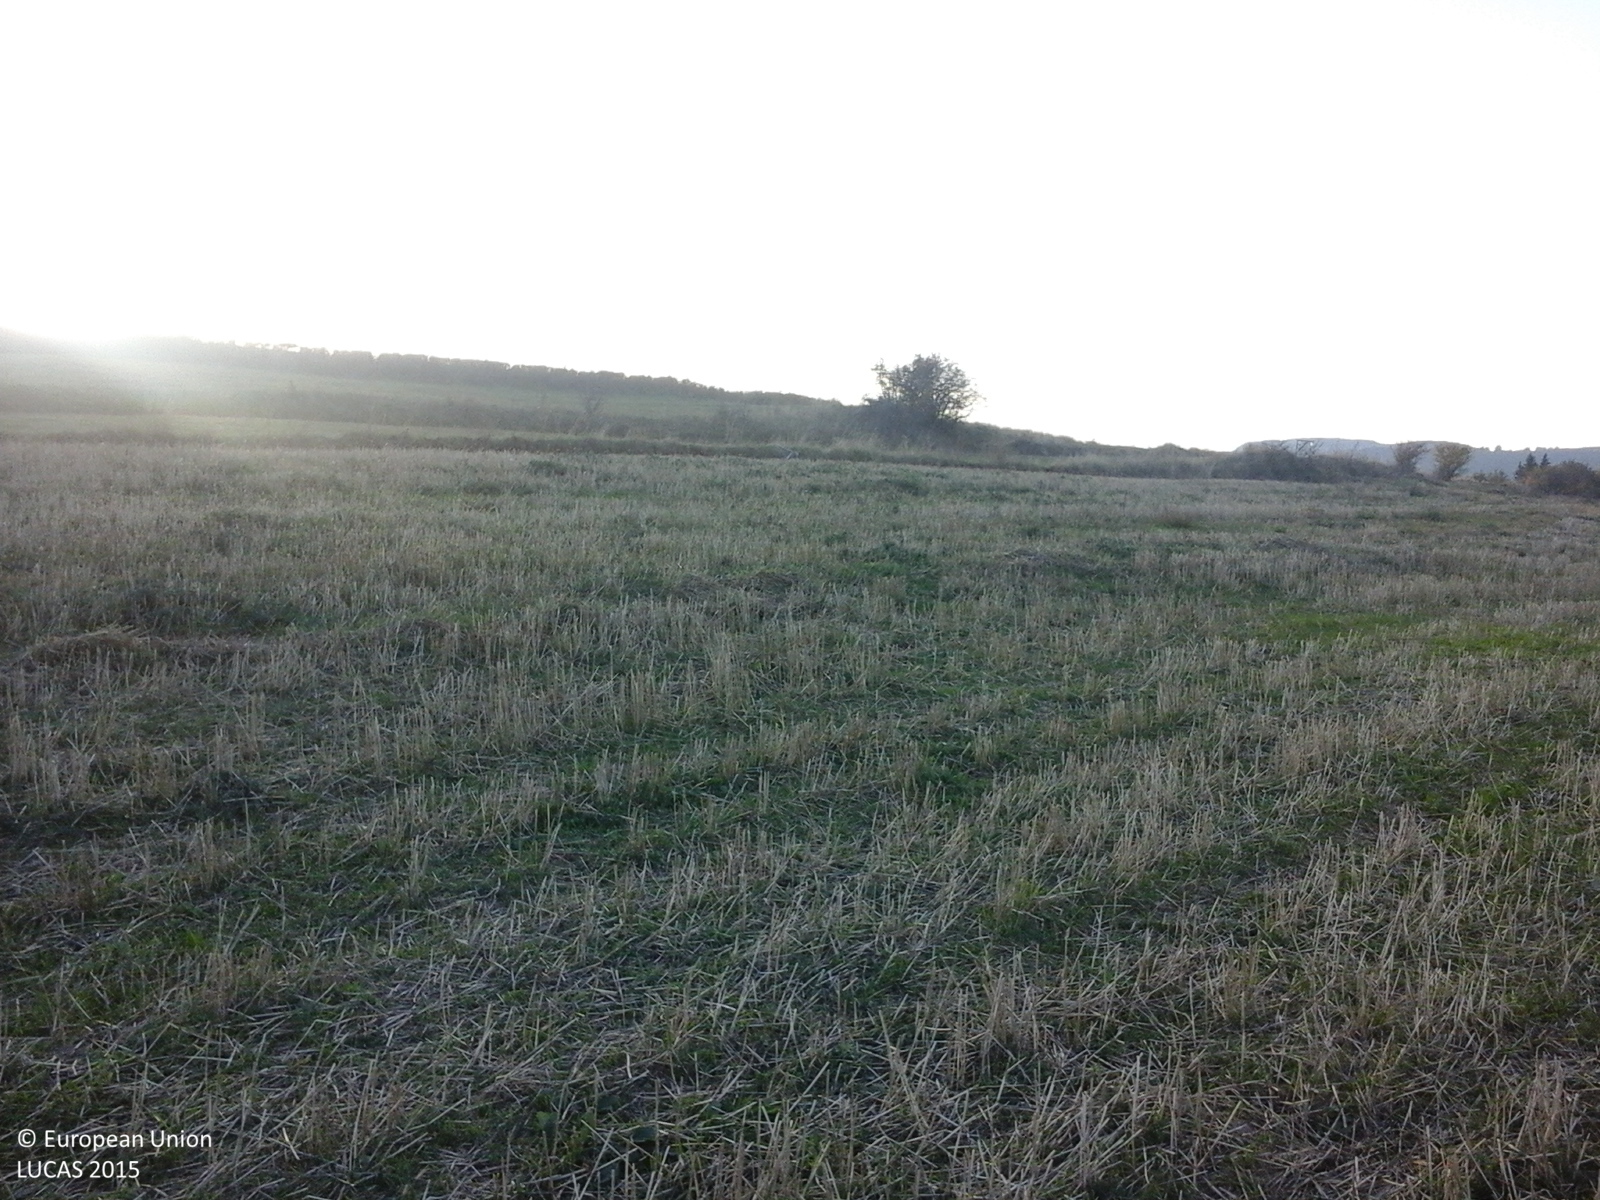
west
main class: Grassland
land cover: Grassland without tree/shrub cover
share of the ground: > 75 %
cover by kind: herbaceous plants 100 %
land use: Agriculture (excluding fallow land and kitchen gardens)
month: October
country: RO
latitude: 46.5127
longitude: 25.1277
